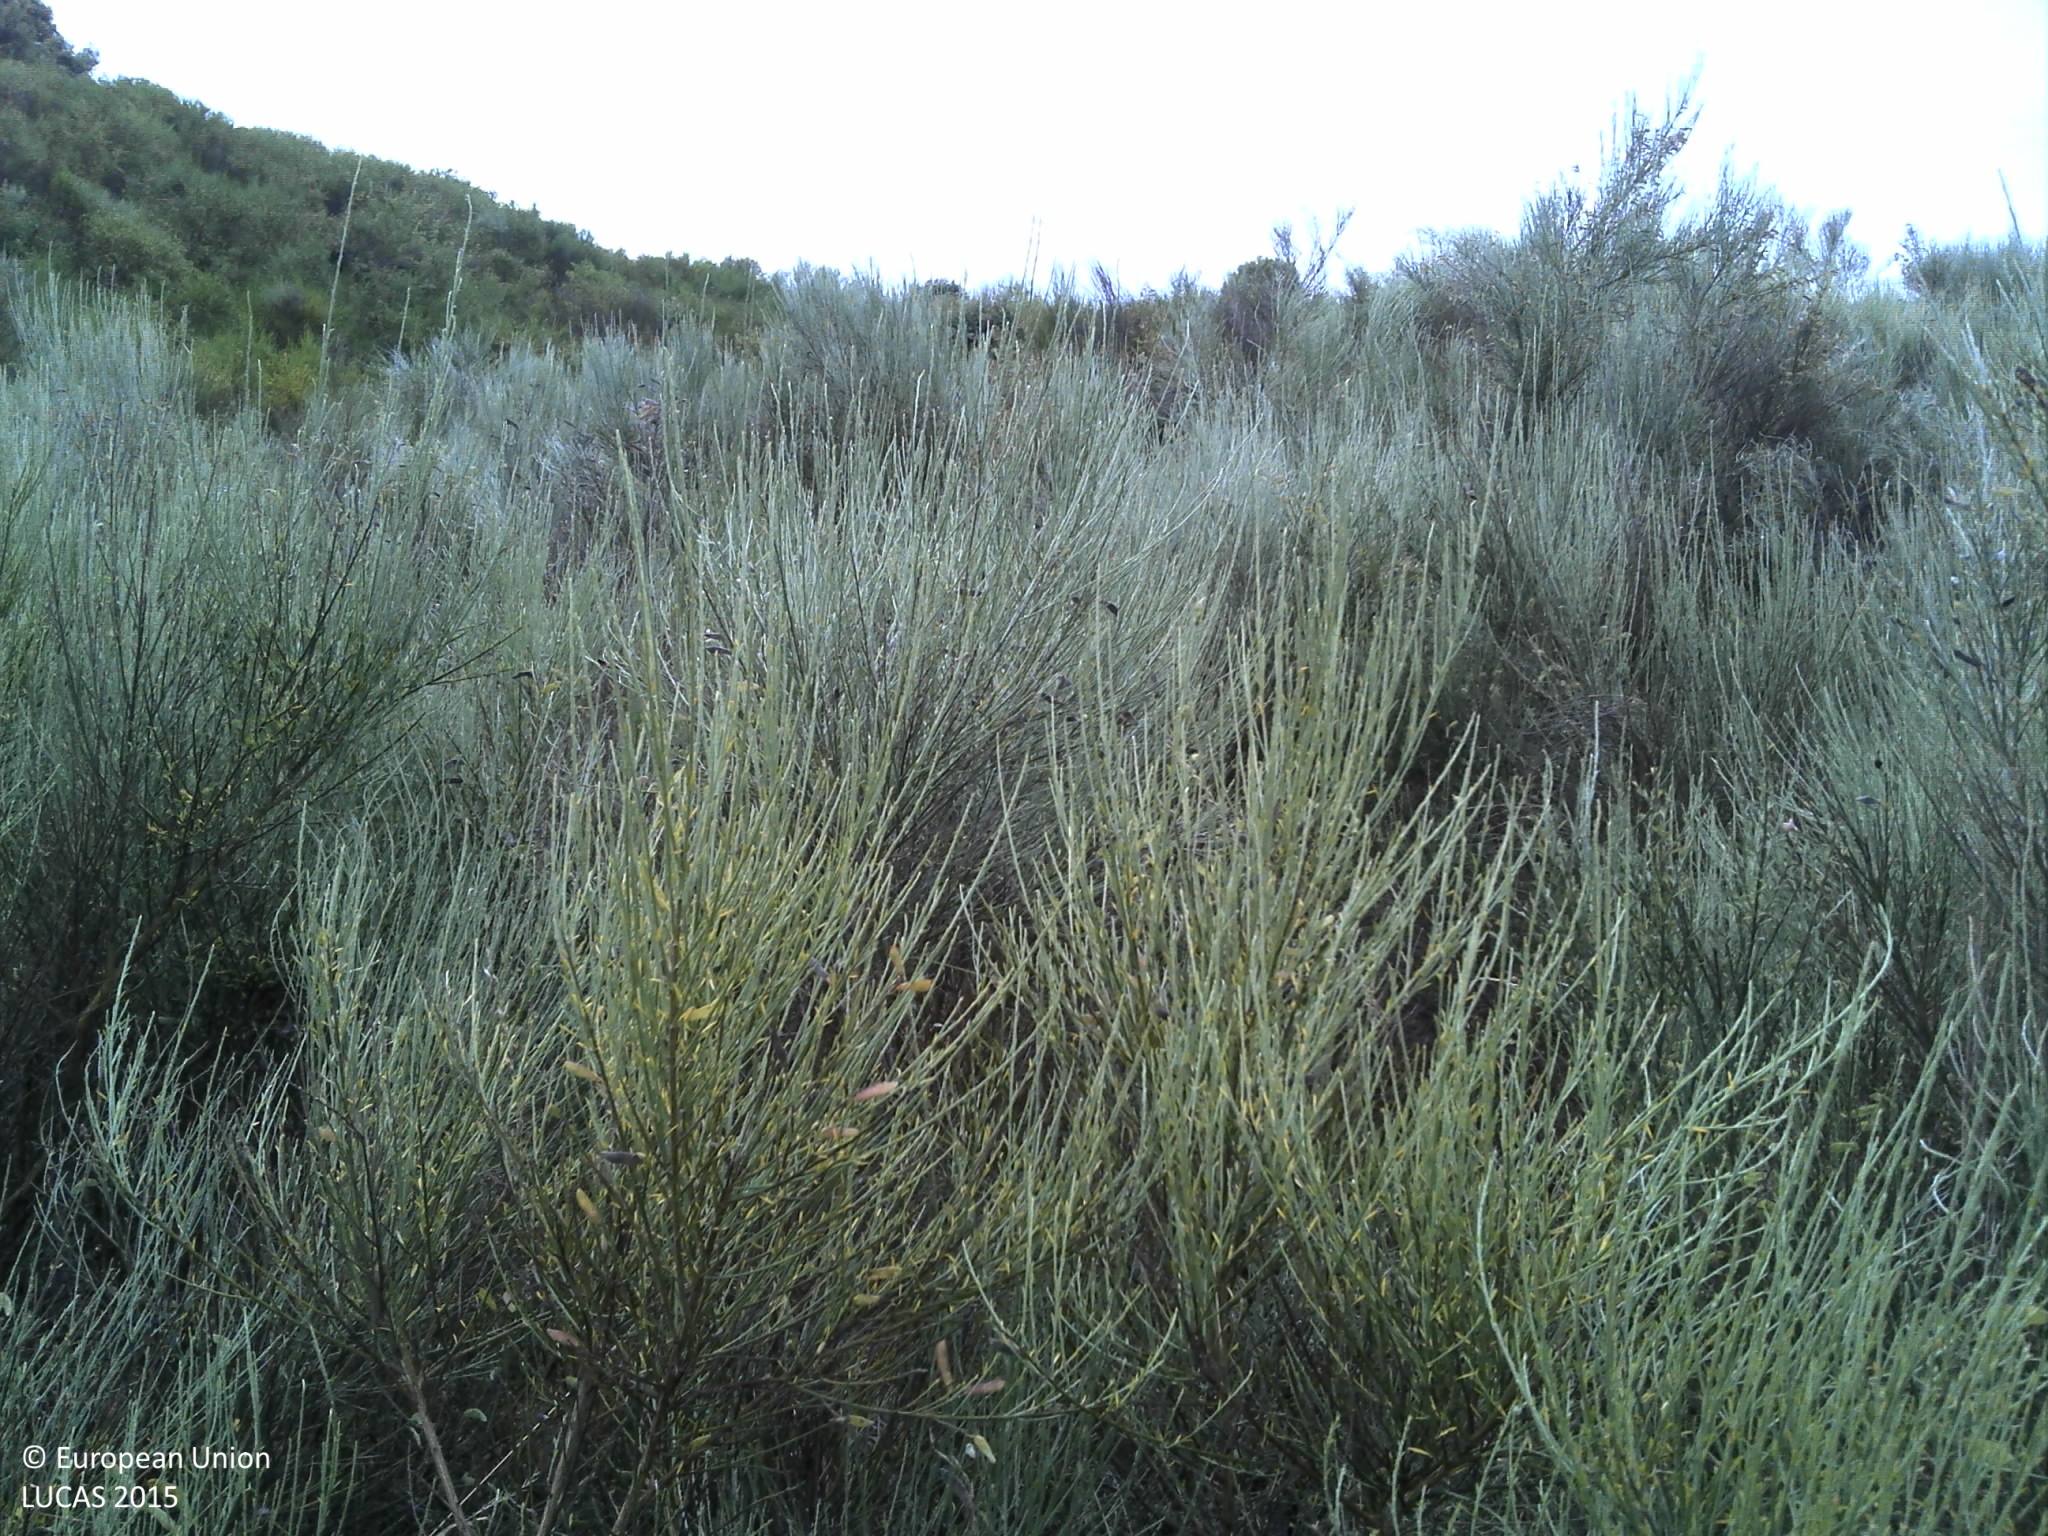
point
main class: Shrubland
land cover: Shrubland without tree cover
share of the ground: > 75 %
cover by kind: shrubs 100 %
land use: Semi-natural and natural areas not in use
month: June
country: PT
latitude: 41.3206
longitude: -6.9676
